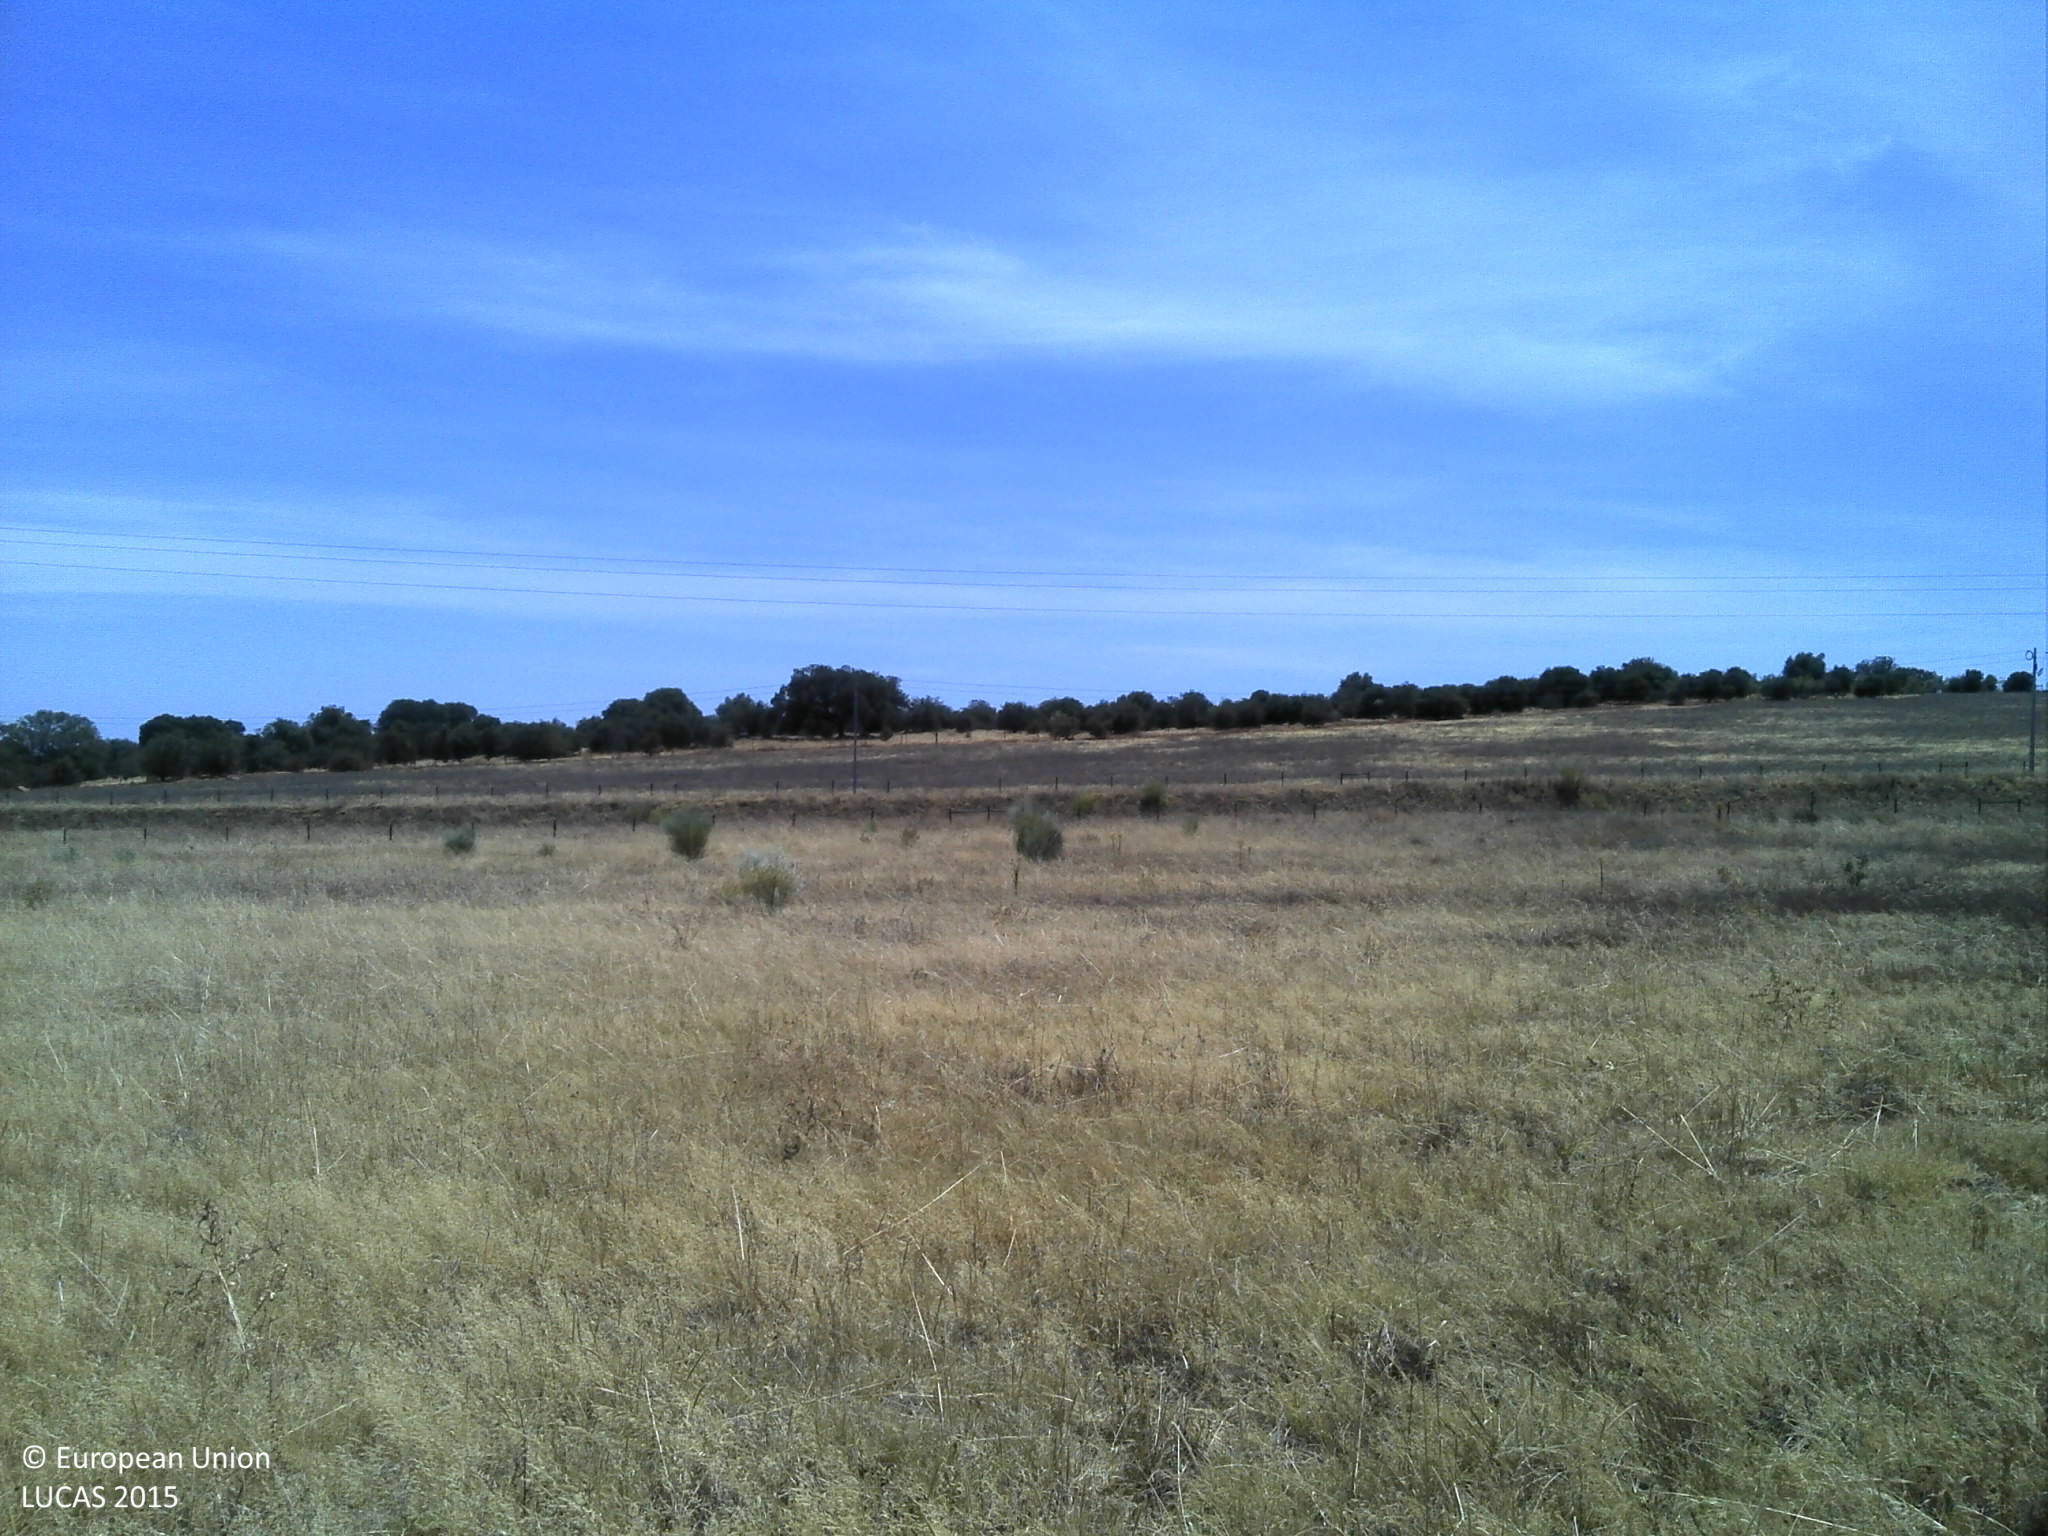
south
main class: Grassland
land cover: Grassland without tree/shrub cover
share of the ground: 25 - 50 %
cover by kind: herbaceous plants 50 %, unconsolidated bare surface 50 %
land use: Agriculture (excluding fallow land and kitchen gardens)
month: July
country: PT
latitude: 38.4178
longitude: -7.4229
